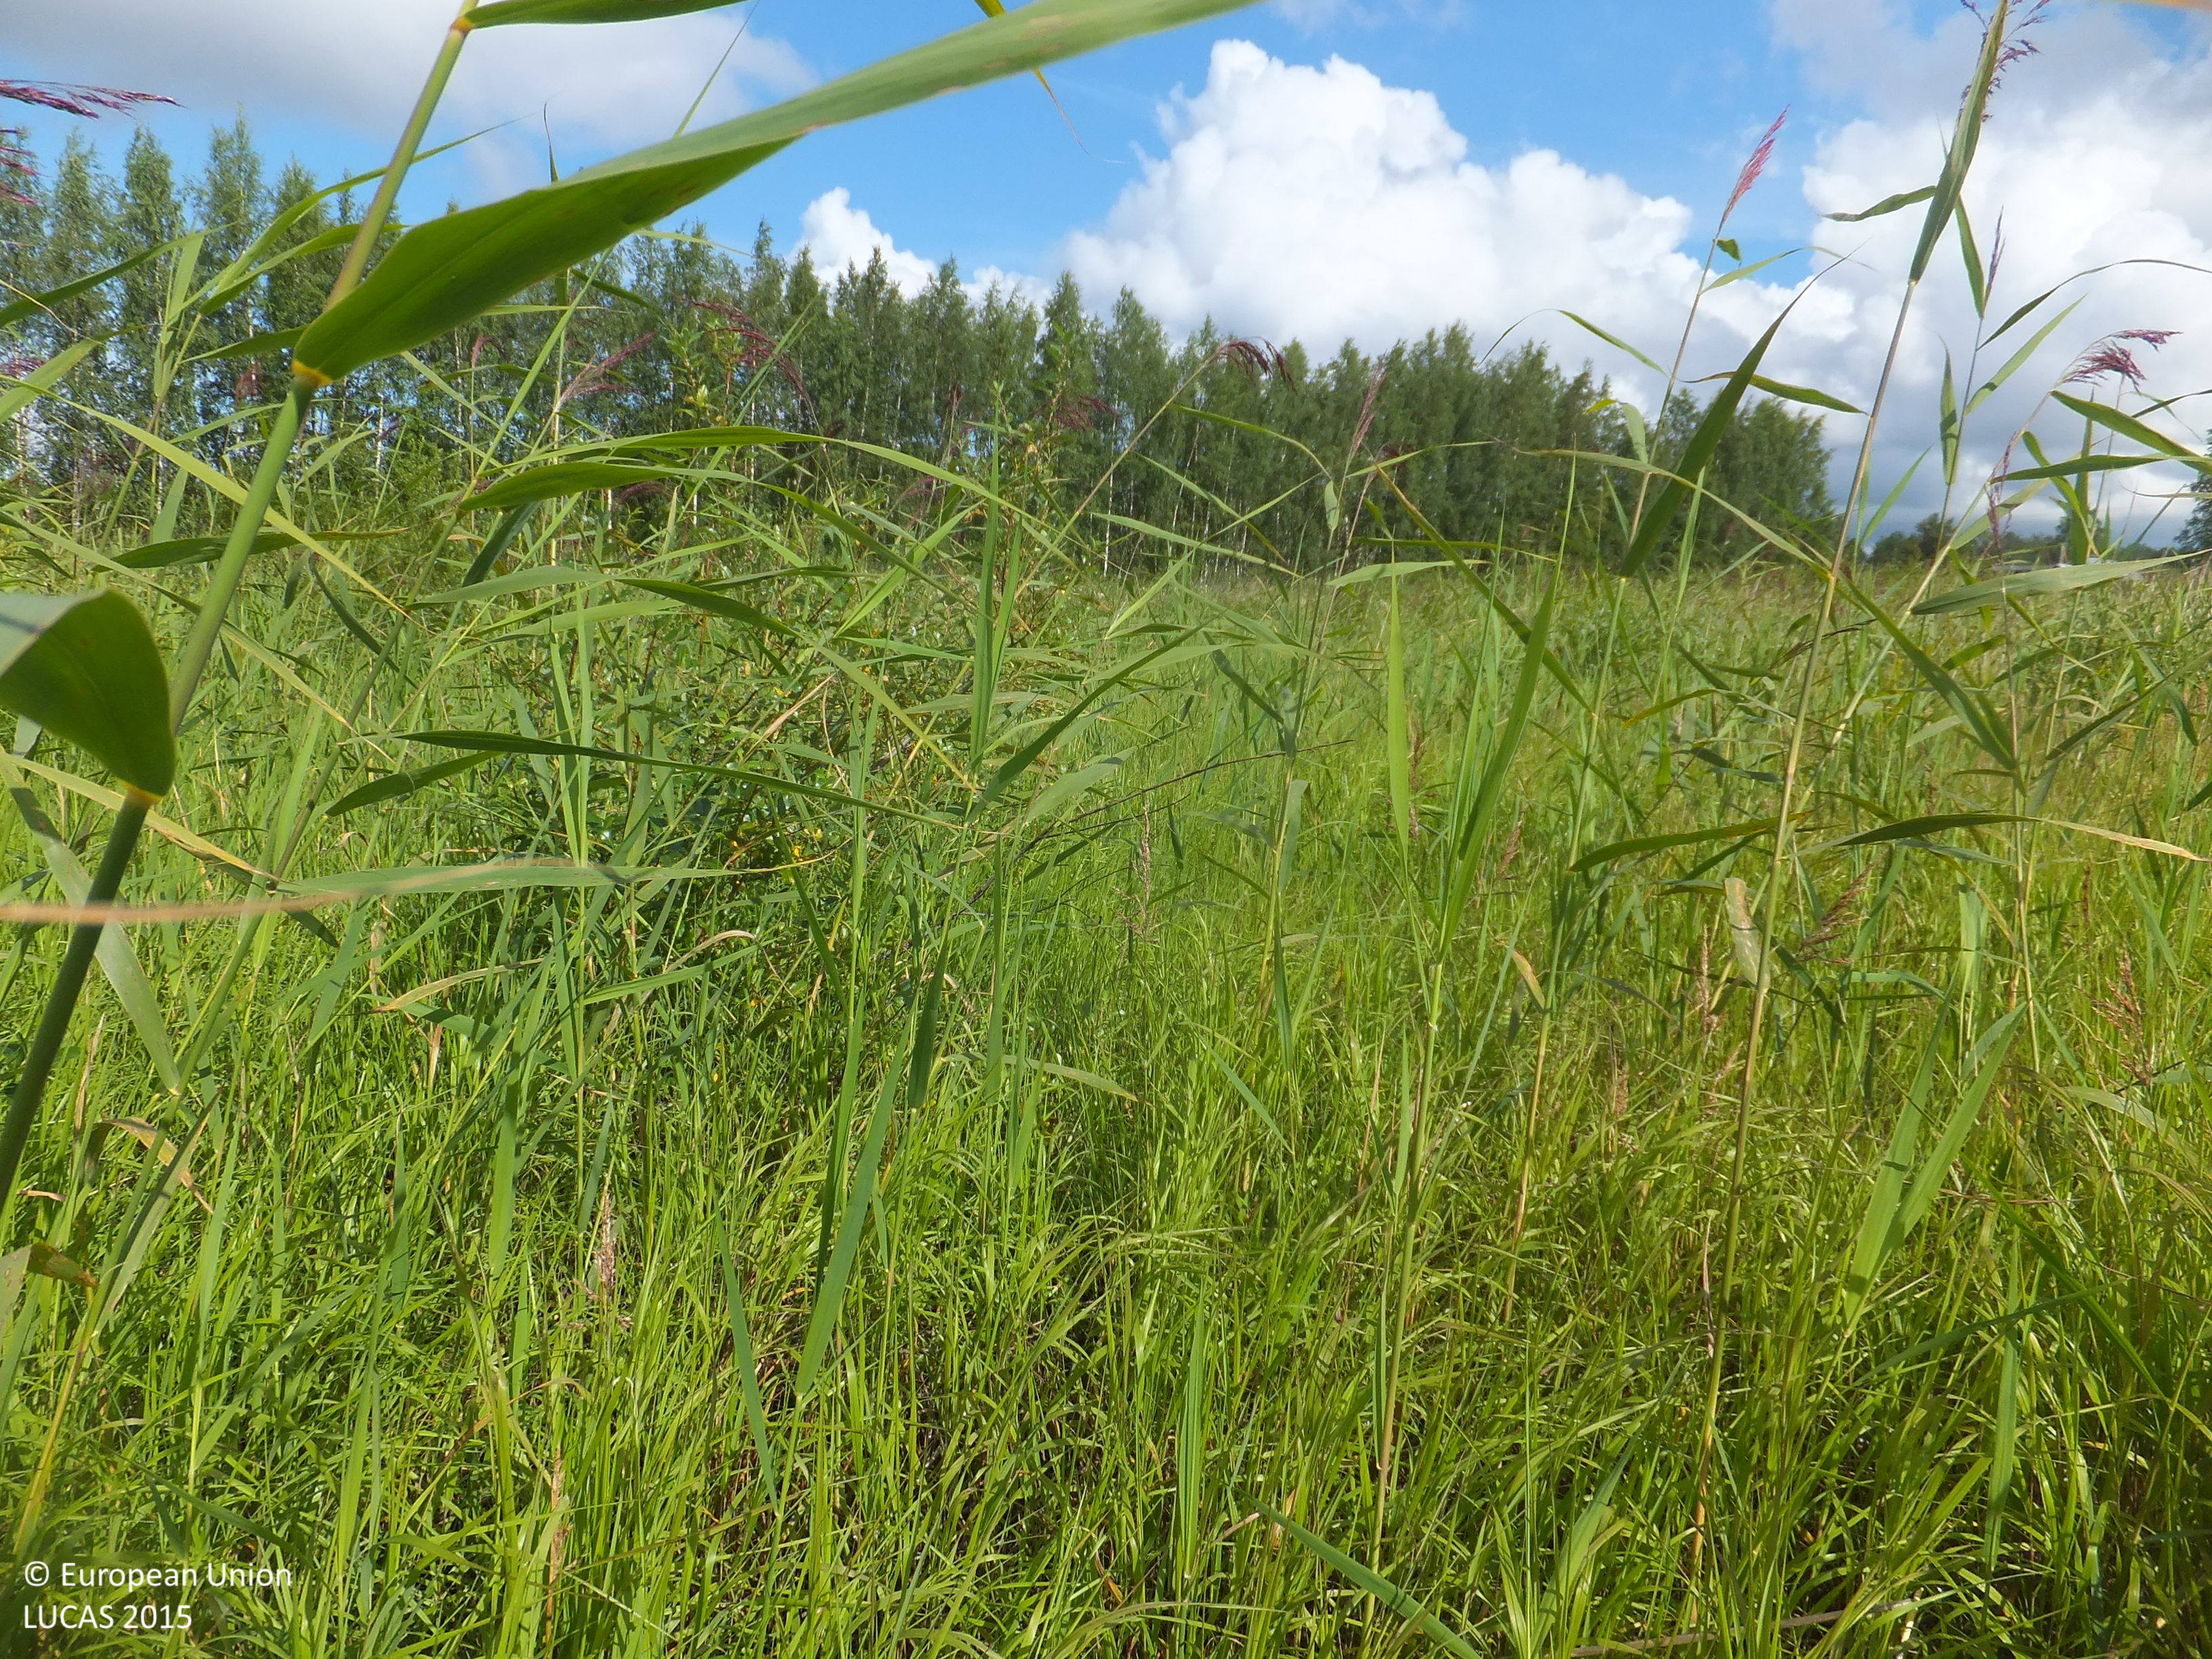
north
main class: Grassland
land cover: Grassland without tree/shrub cover
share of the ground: > 75 %
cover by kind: herbaceous plants 100 %
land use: Semi-natural and natural areas not in use
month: July
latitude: 63.2243
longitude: 22.0414
